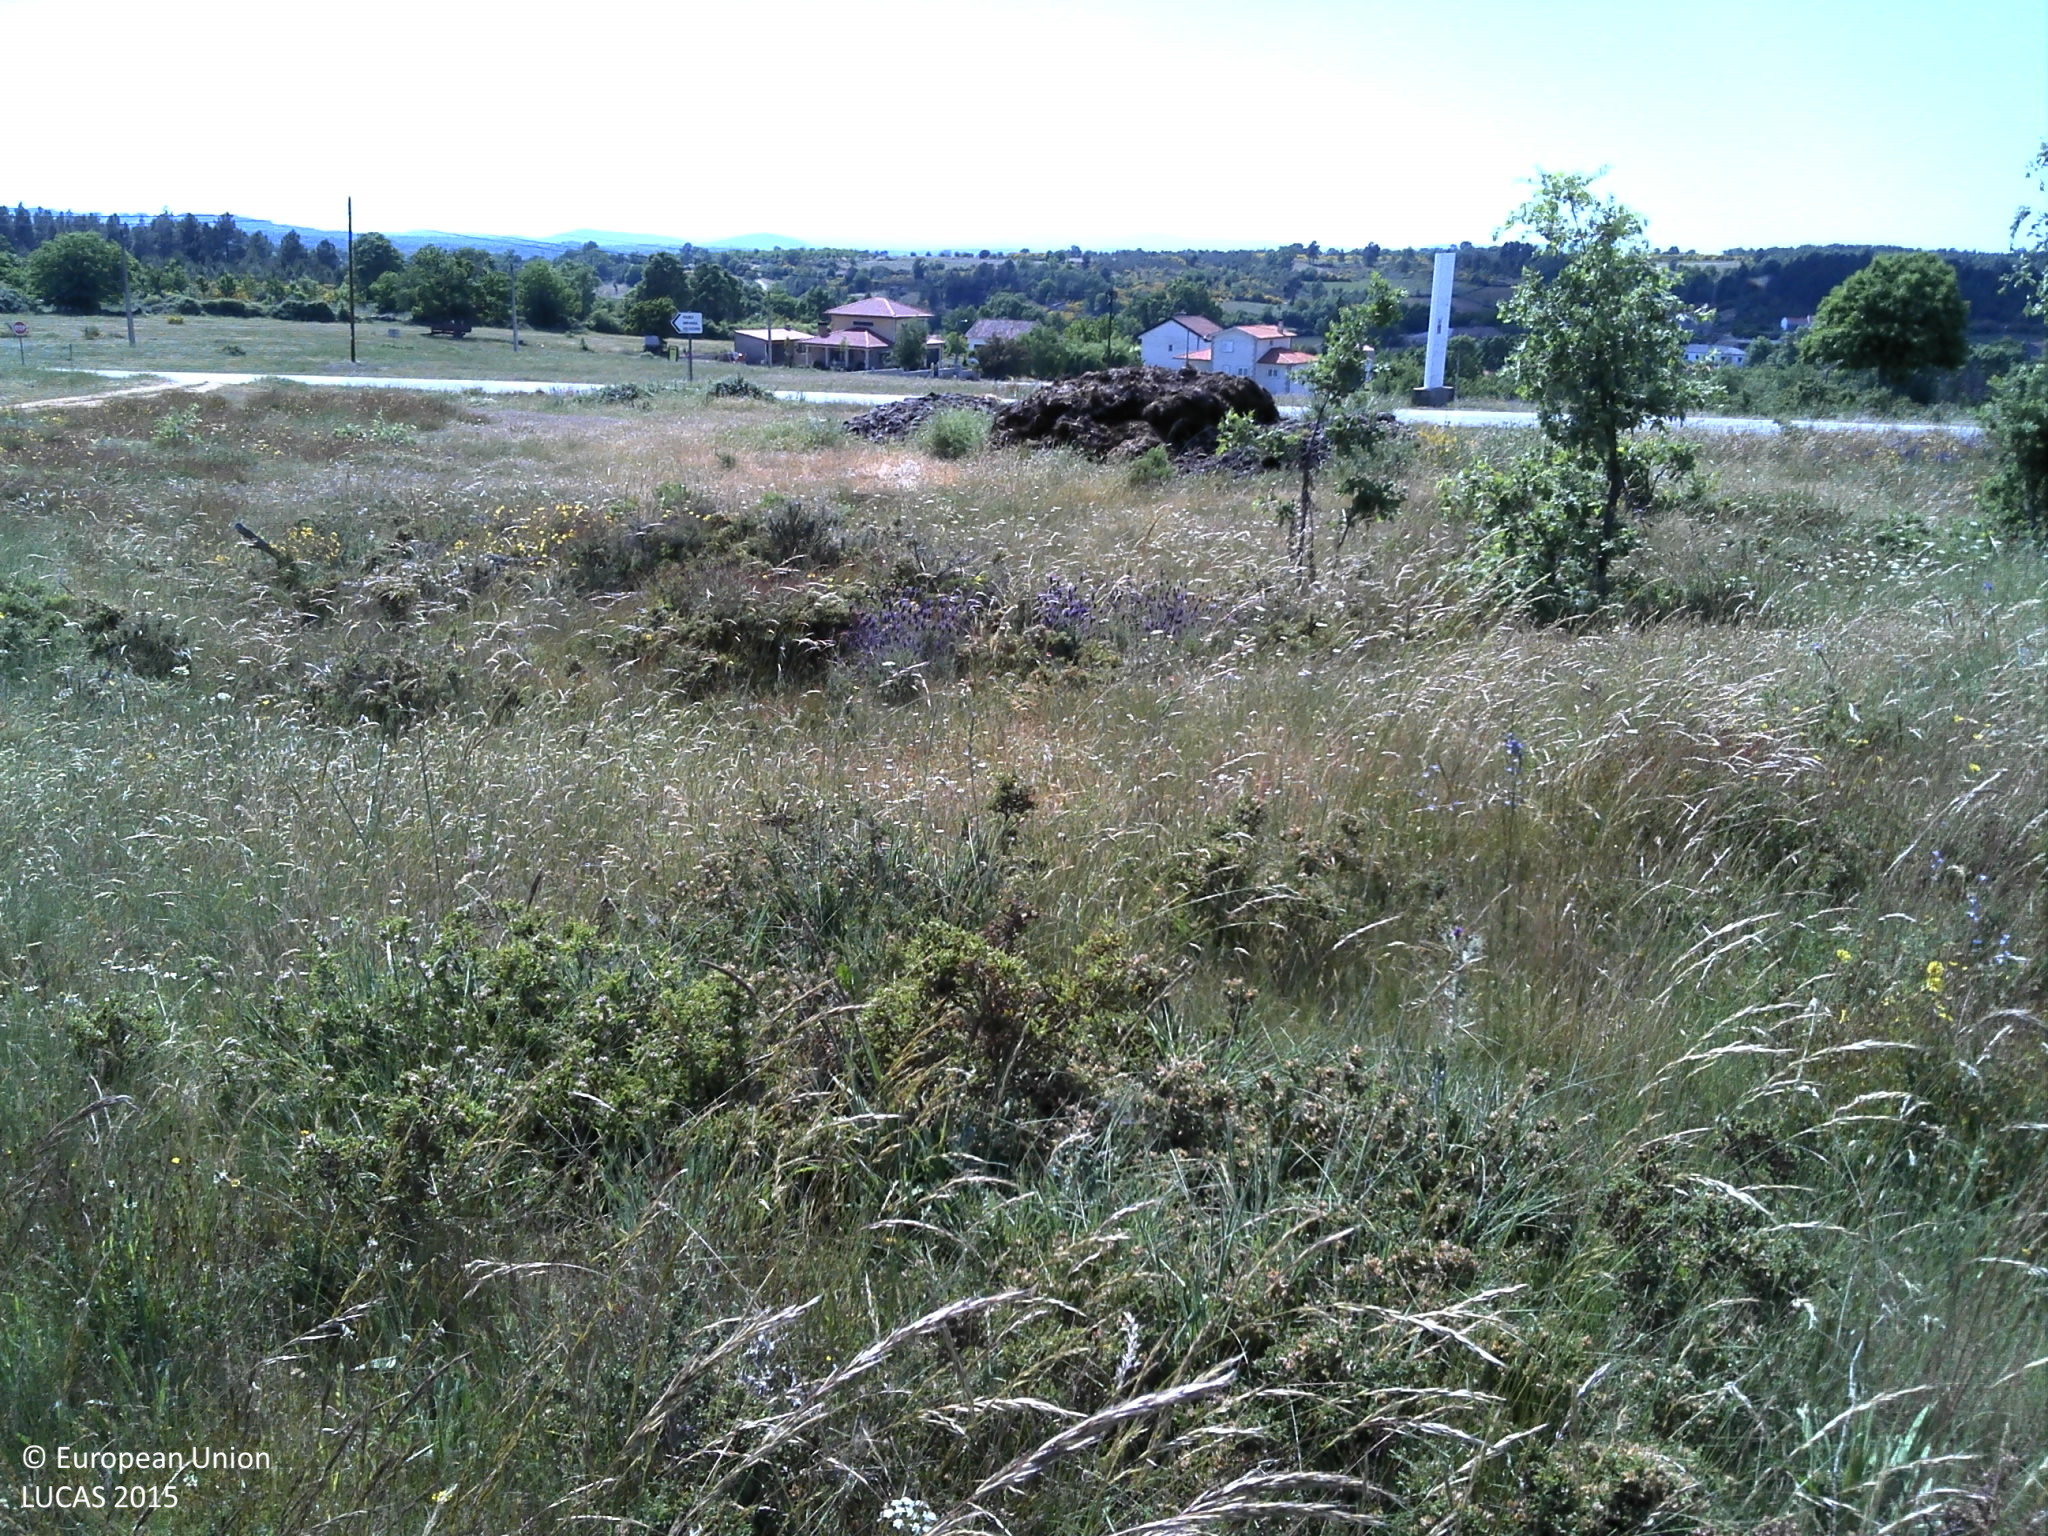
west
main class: Grassland
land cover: Grassland without tree/shrub cover
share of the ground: > 75 %
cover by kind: herbaceous plants 95 %, shrubs 5 %
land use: Abandoned areas
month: May
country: PT
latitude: 41.6230
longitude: -6.2662
